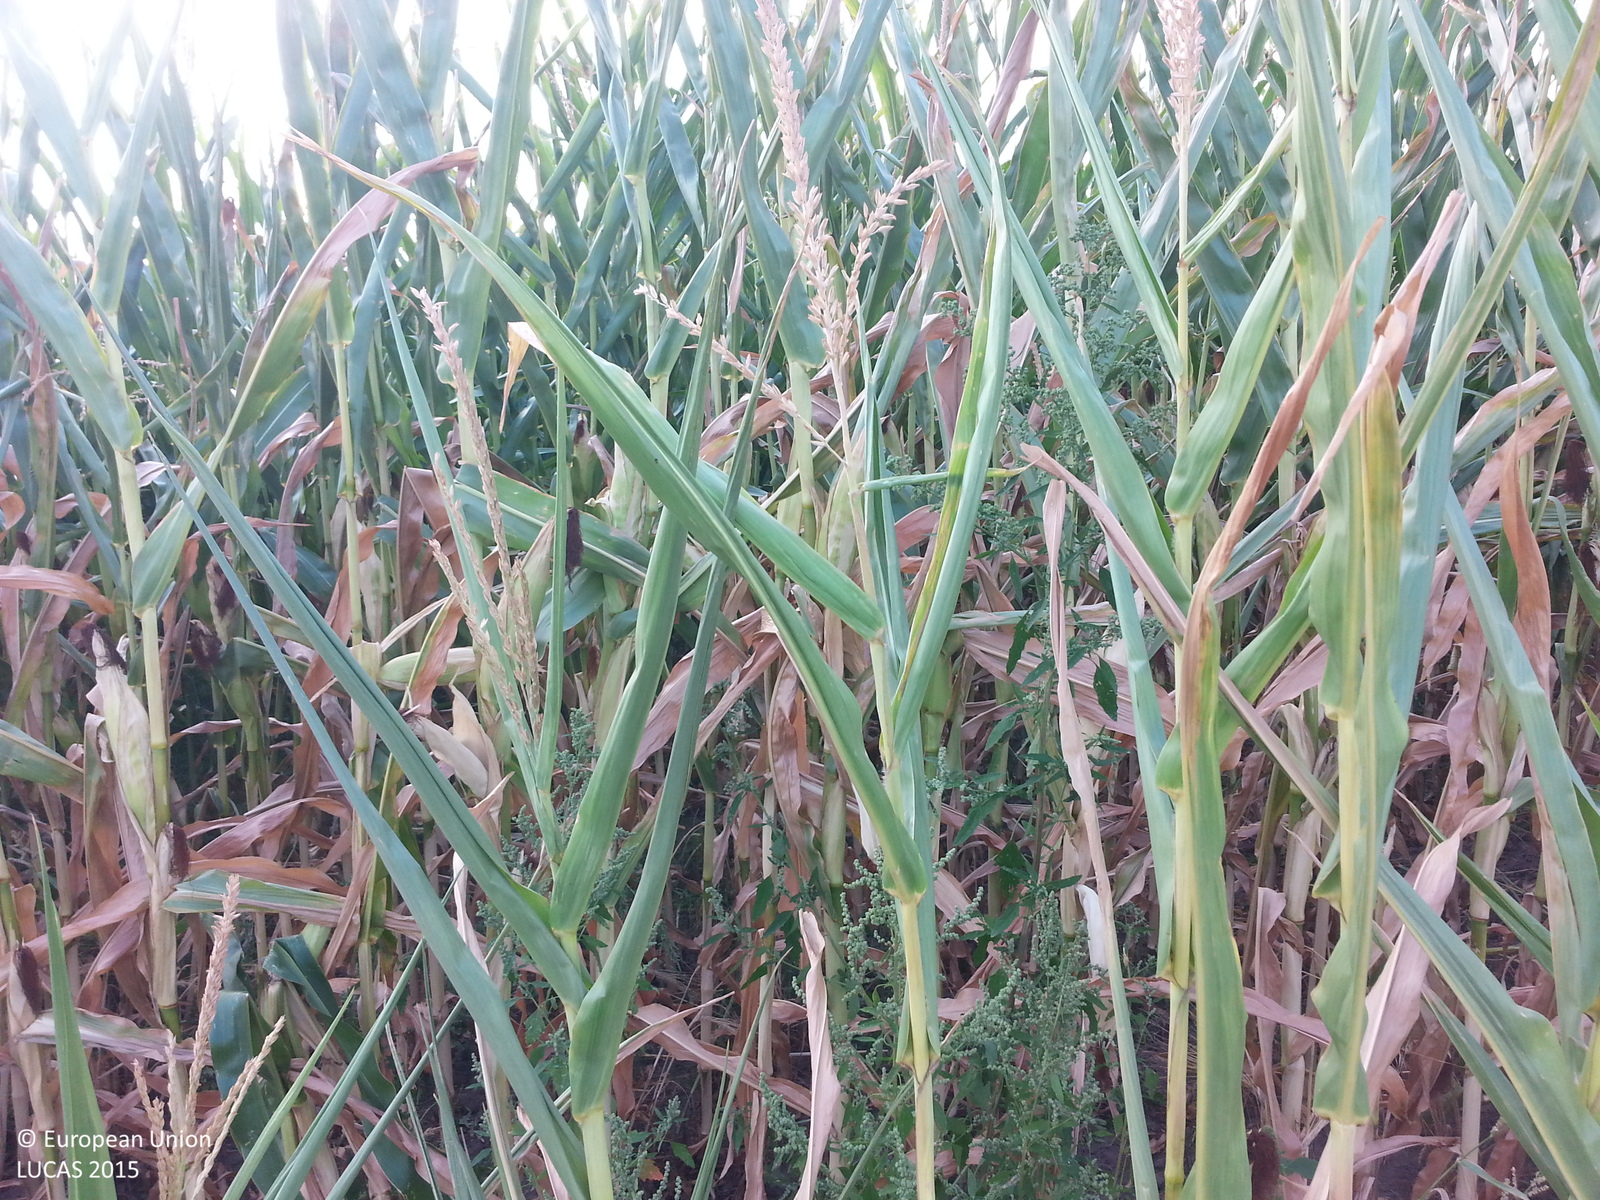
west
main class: Cropland
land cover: Maize
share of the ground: > 75 %
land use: Agriculture (excluding fallow land and kitchen gardens)
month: August
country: PL
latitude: 52.9311
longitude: 19.1135
